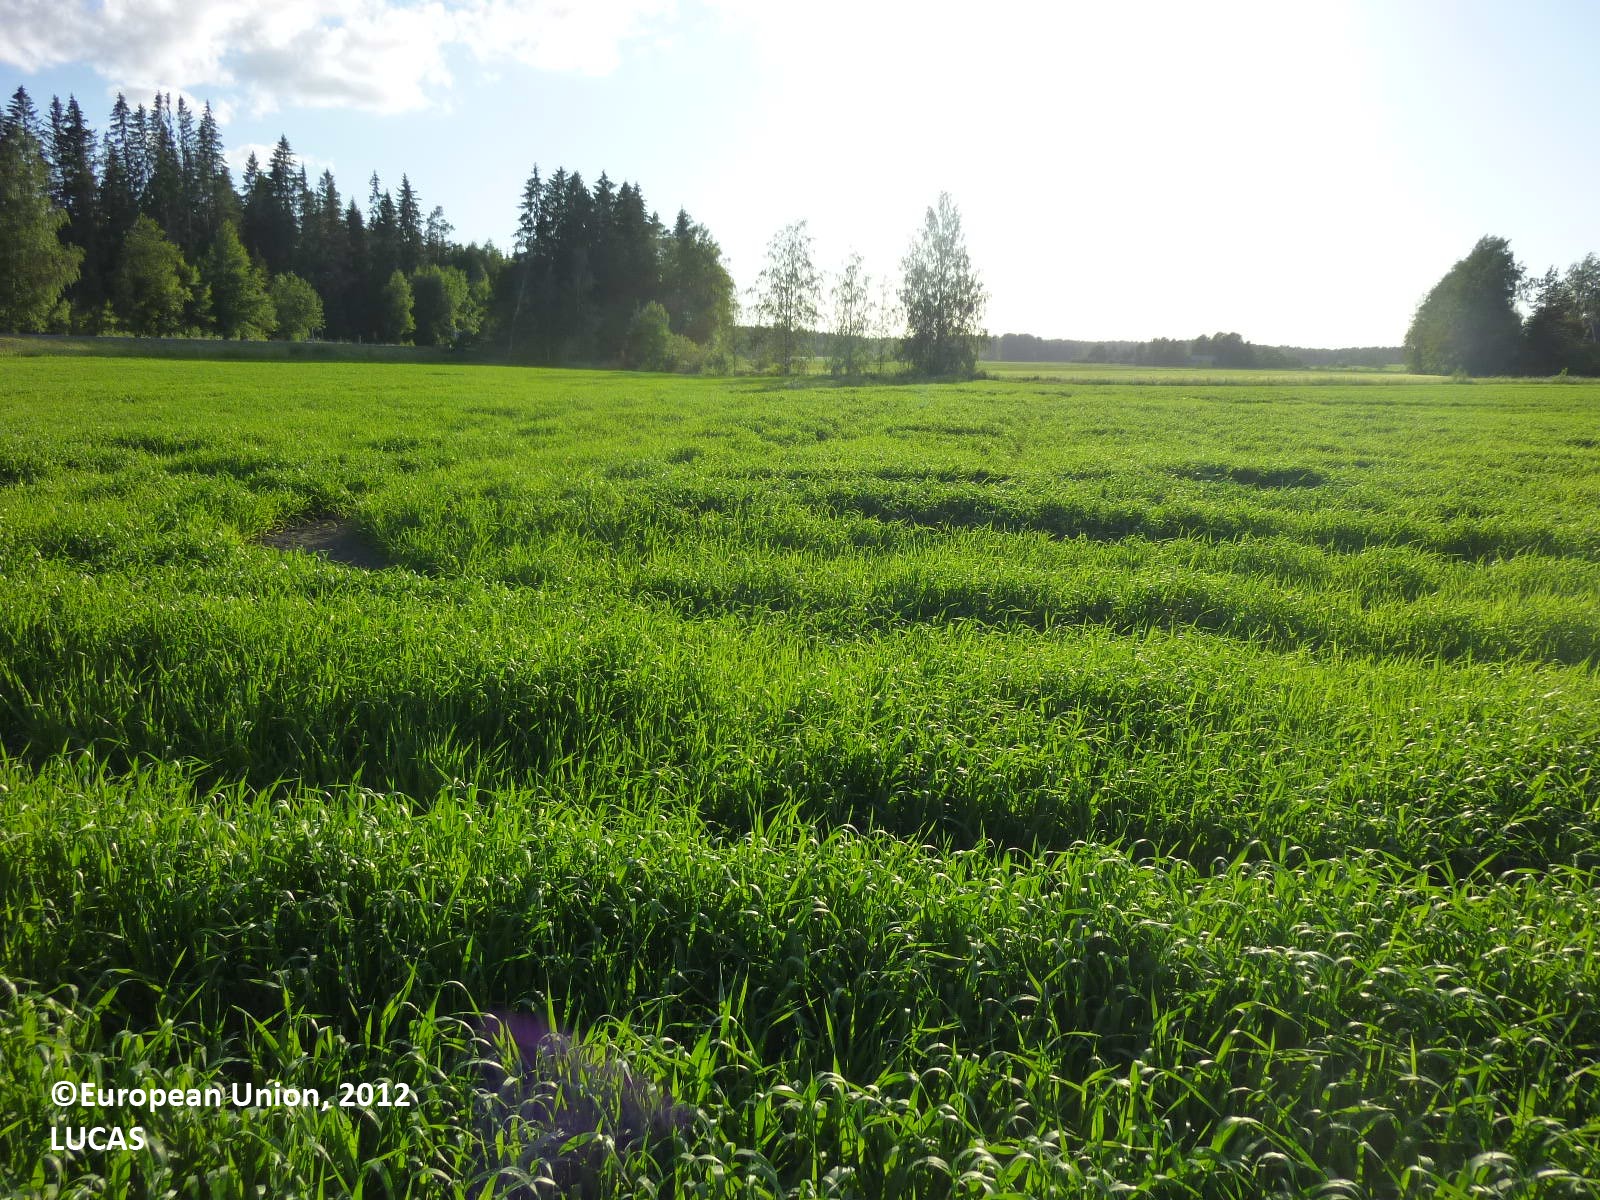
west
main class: Cropland
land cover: Barley
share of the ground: > 75 %
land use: Agriculture (excluding fallow land and kitchen gardens)
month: July
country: FI
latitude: 61.1920
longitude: 22.5113
